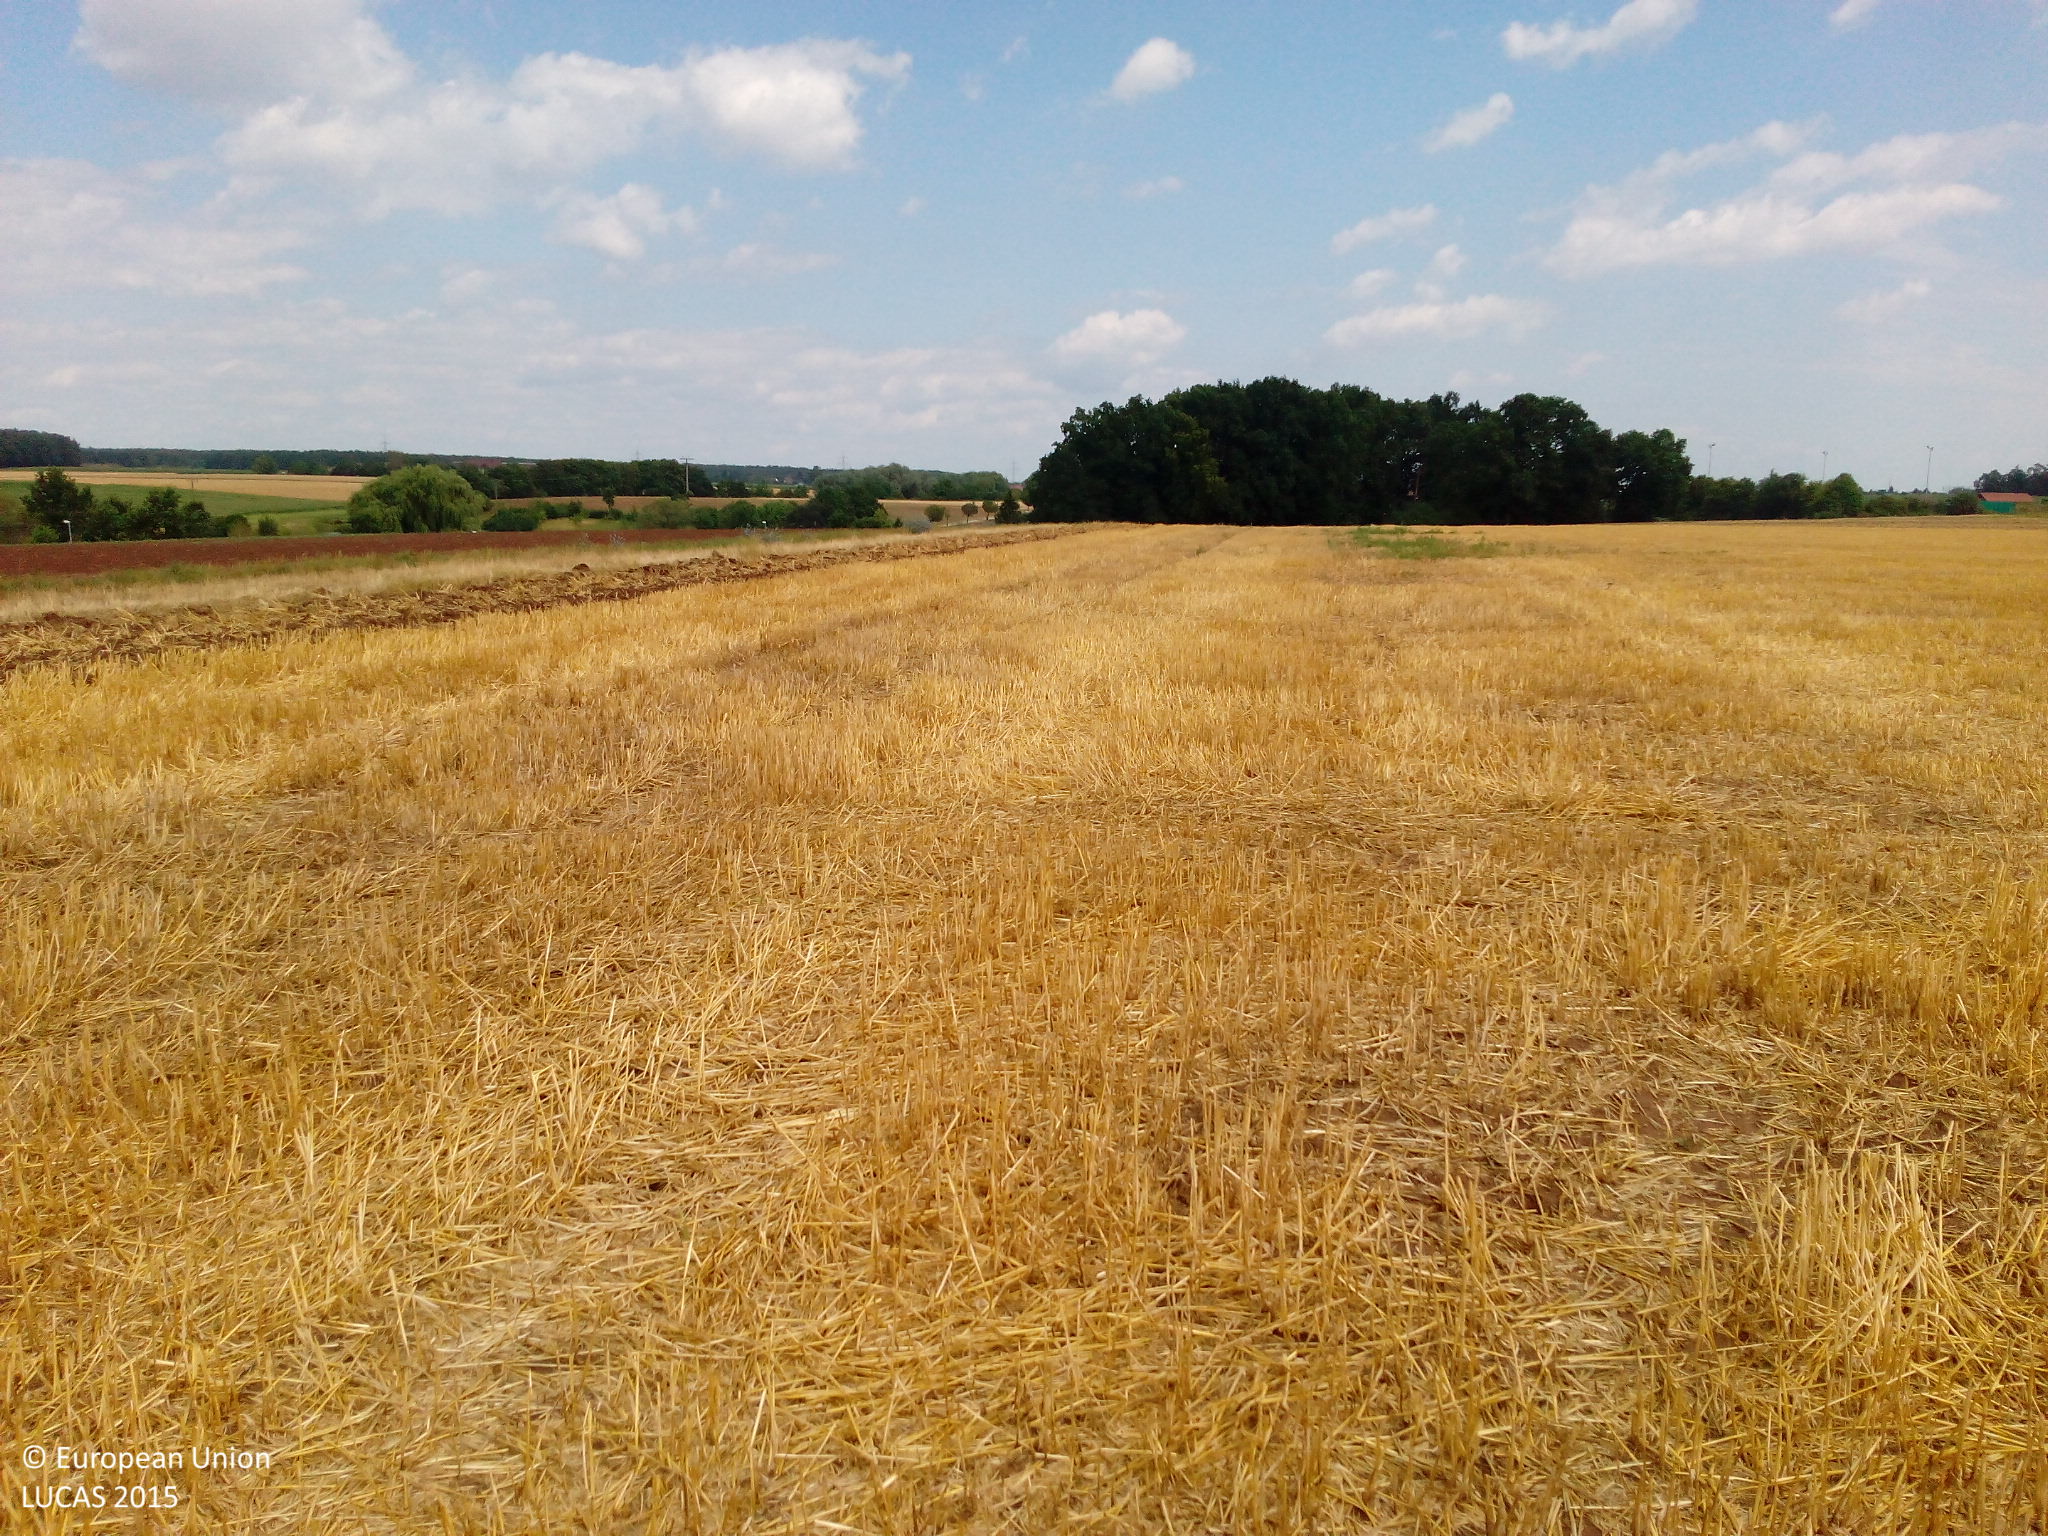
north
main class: Cropland
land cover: Barley
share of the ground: 25 - 50 %
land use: Agriculture (excluding fallow land and kitchen gardens)
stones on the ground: < 10 %
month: July
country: DE
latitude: 49.5153
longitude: 10.8975
